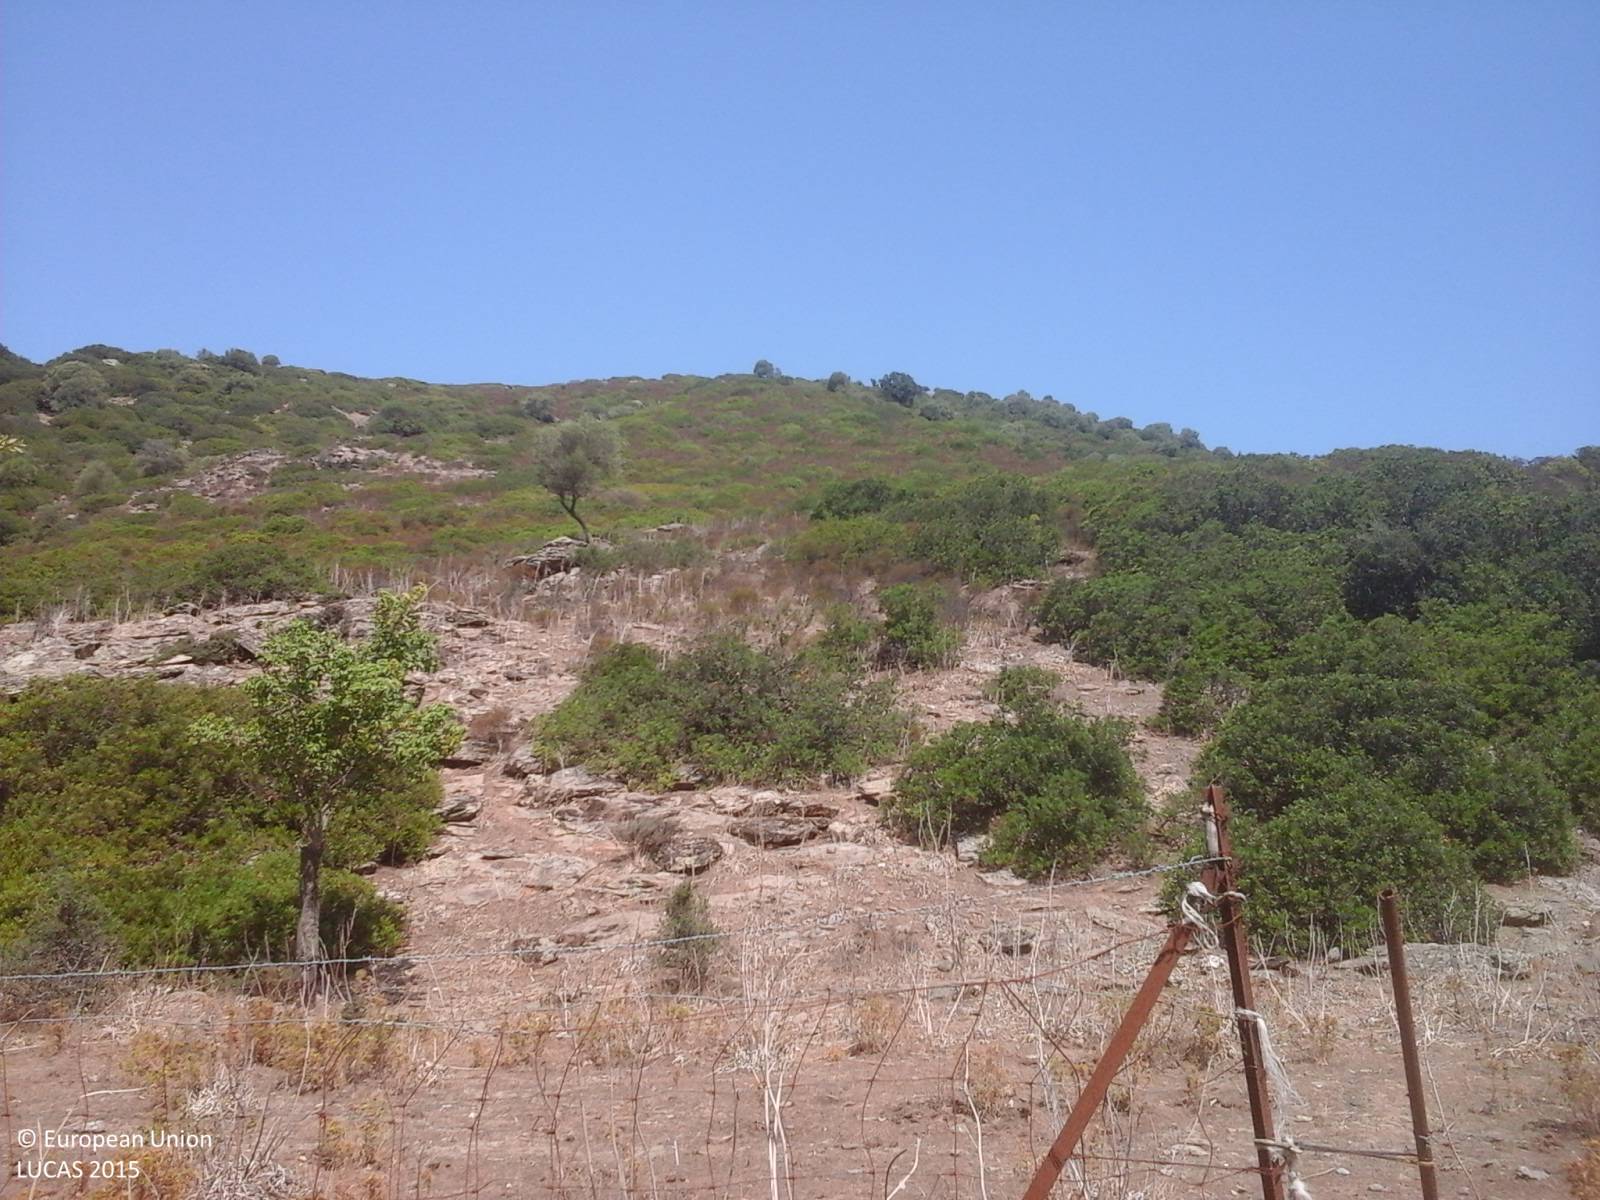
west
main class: Shrubland
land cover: Shrubland without tree cover
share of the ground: > 75 %
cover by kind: shrubs 85 %, unconsolidated bare surface 15 %
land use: Semi-natural and natural areas not in use
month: July
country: IT
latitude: 39.5232
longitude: 9.4334
